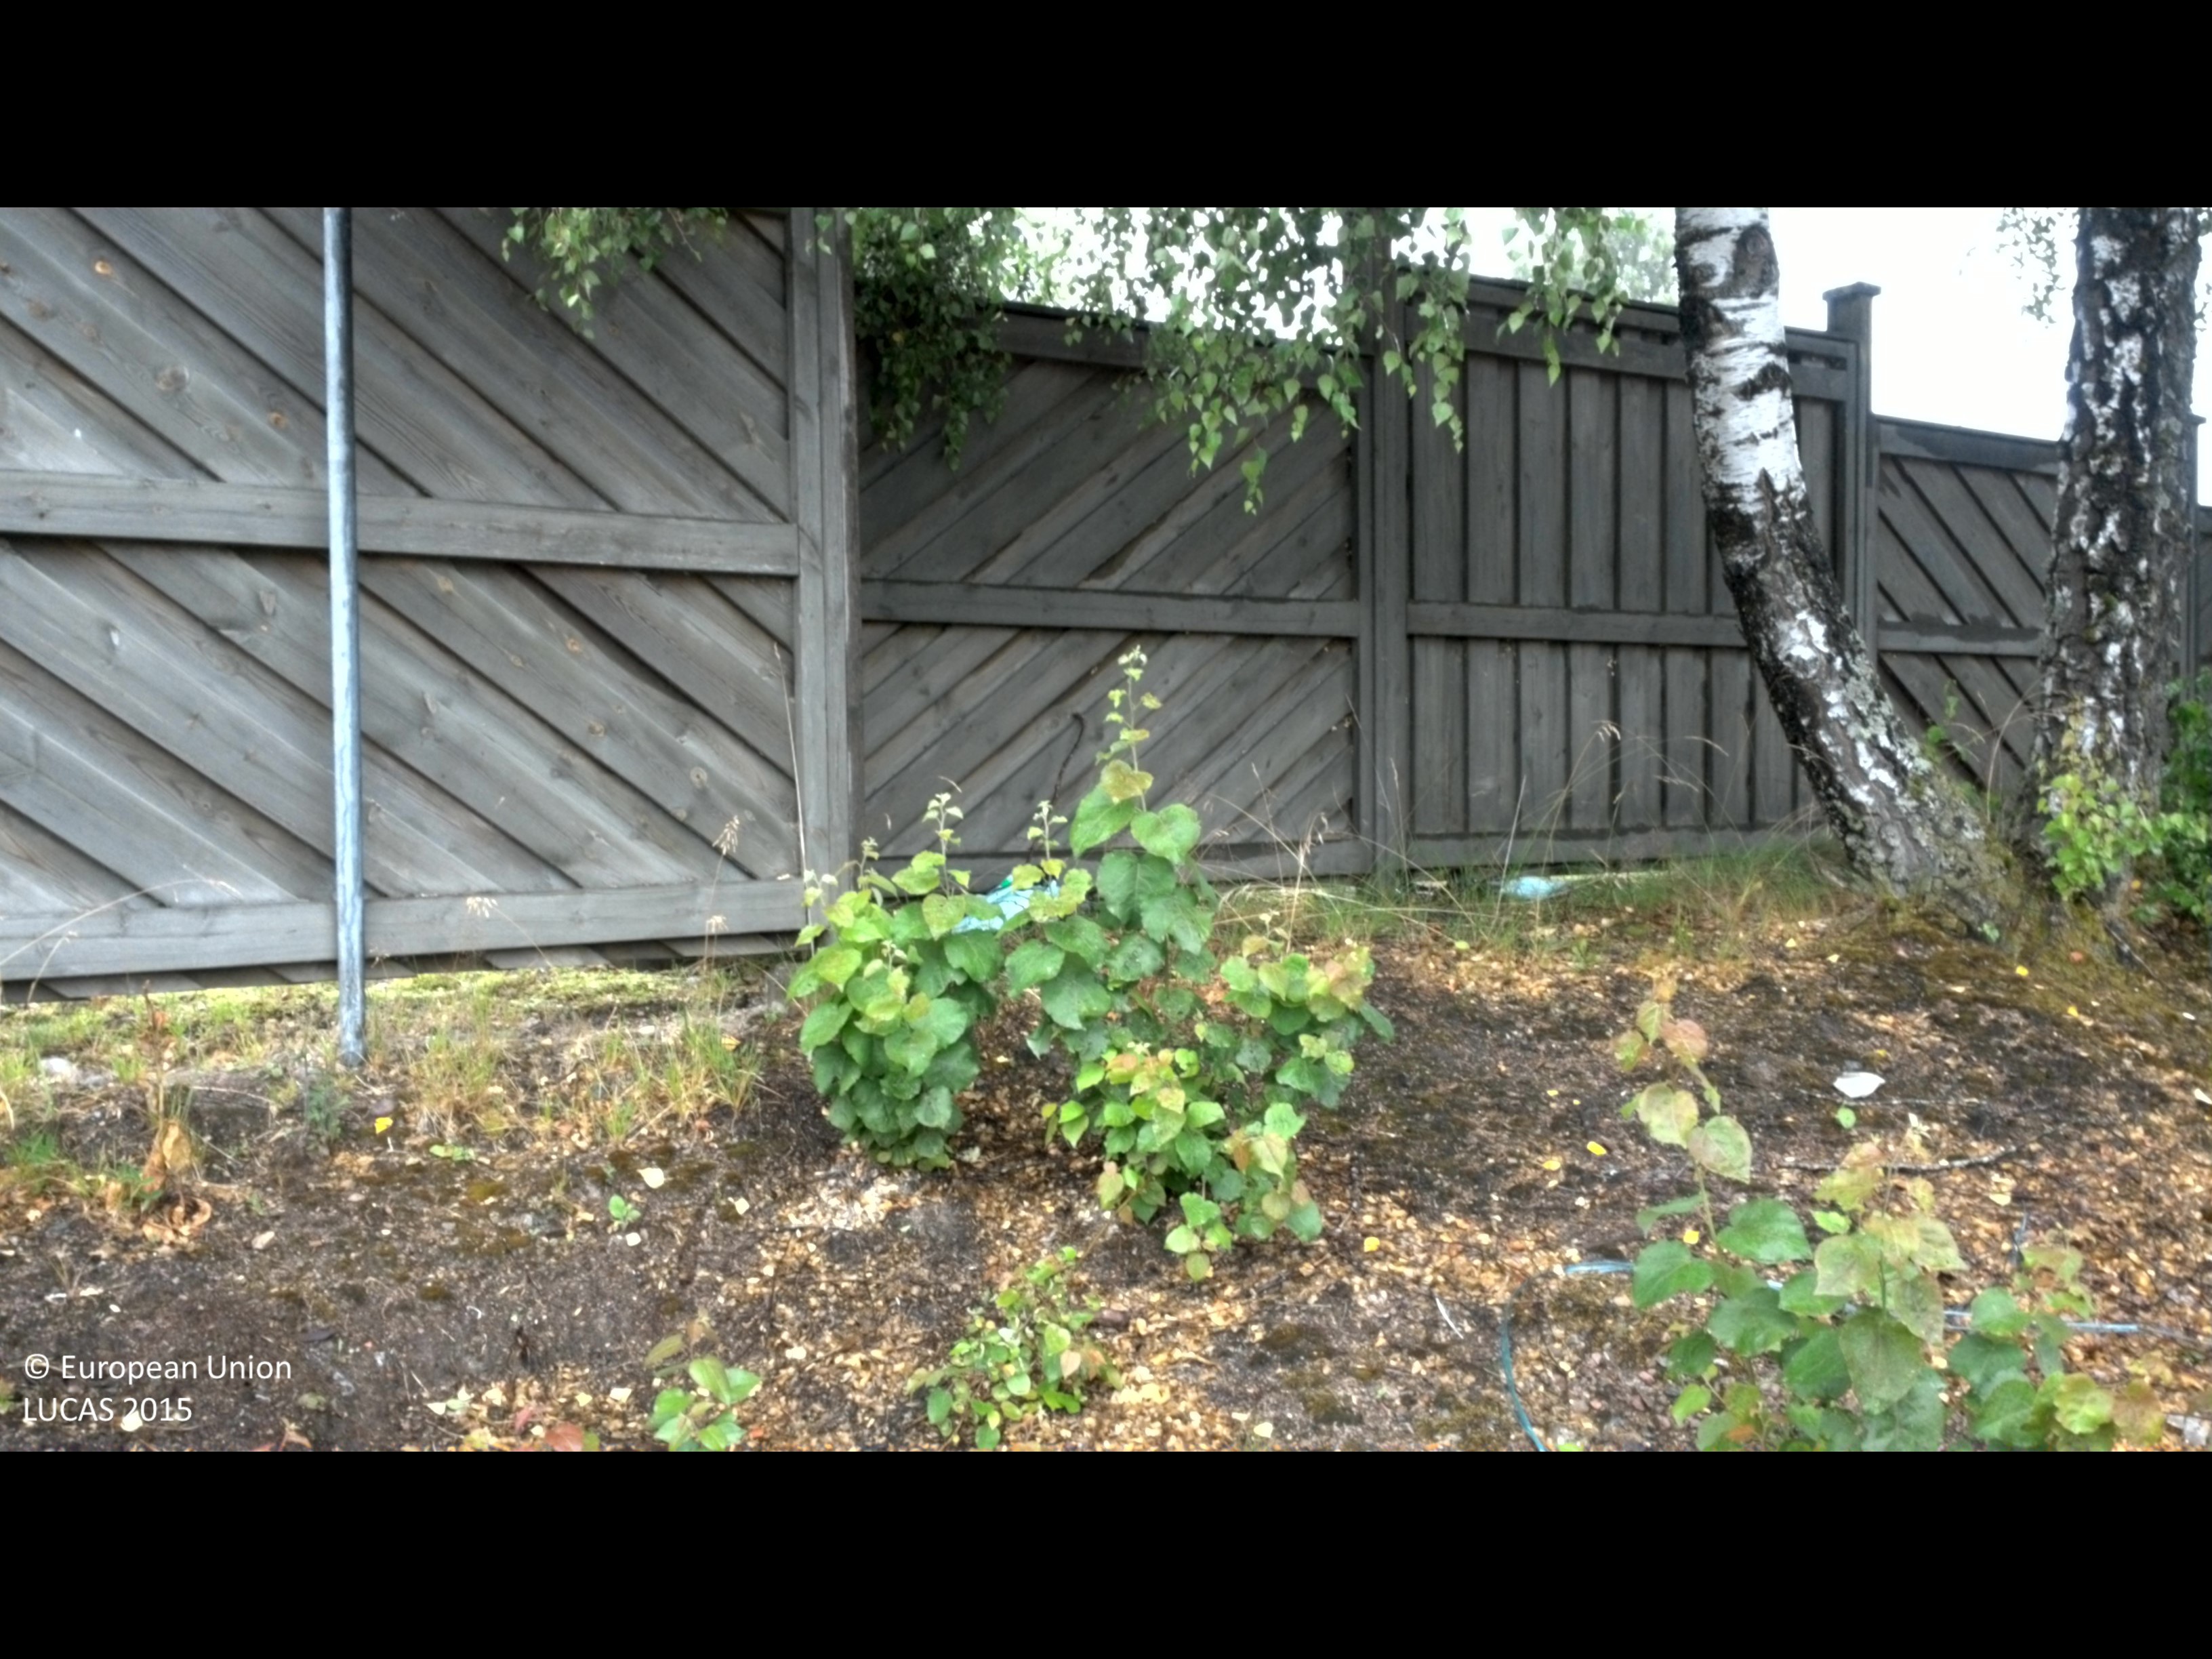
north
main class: Woodland
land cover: Broadleaved woodland
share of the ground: 25 - 50 %
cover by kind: broadleaved forest trees 50 %, herbaceous plants 20 %, lichens and mosses 20 %, unconsolidated bare surface 10 %
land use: Semi-natural and natural areas not in use
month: July
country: SE
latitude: 56.5828
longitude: 13.7578
